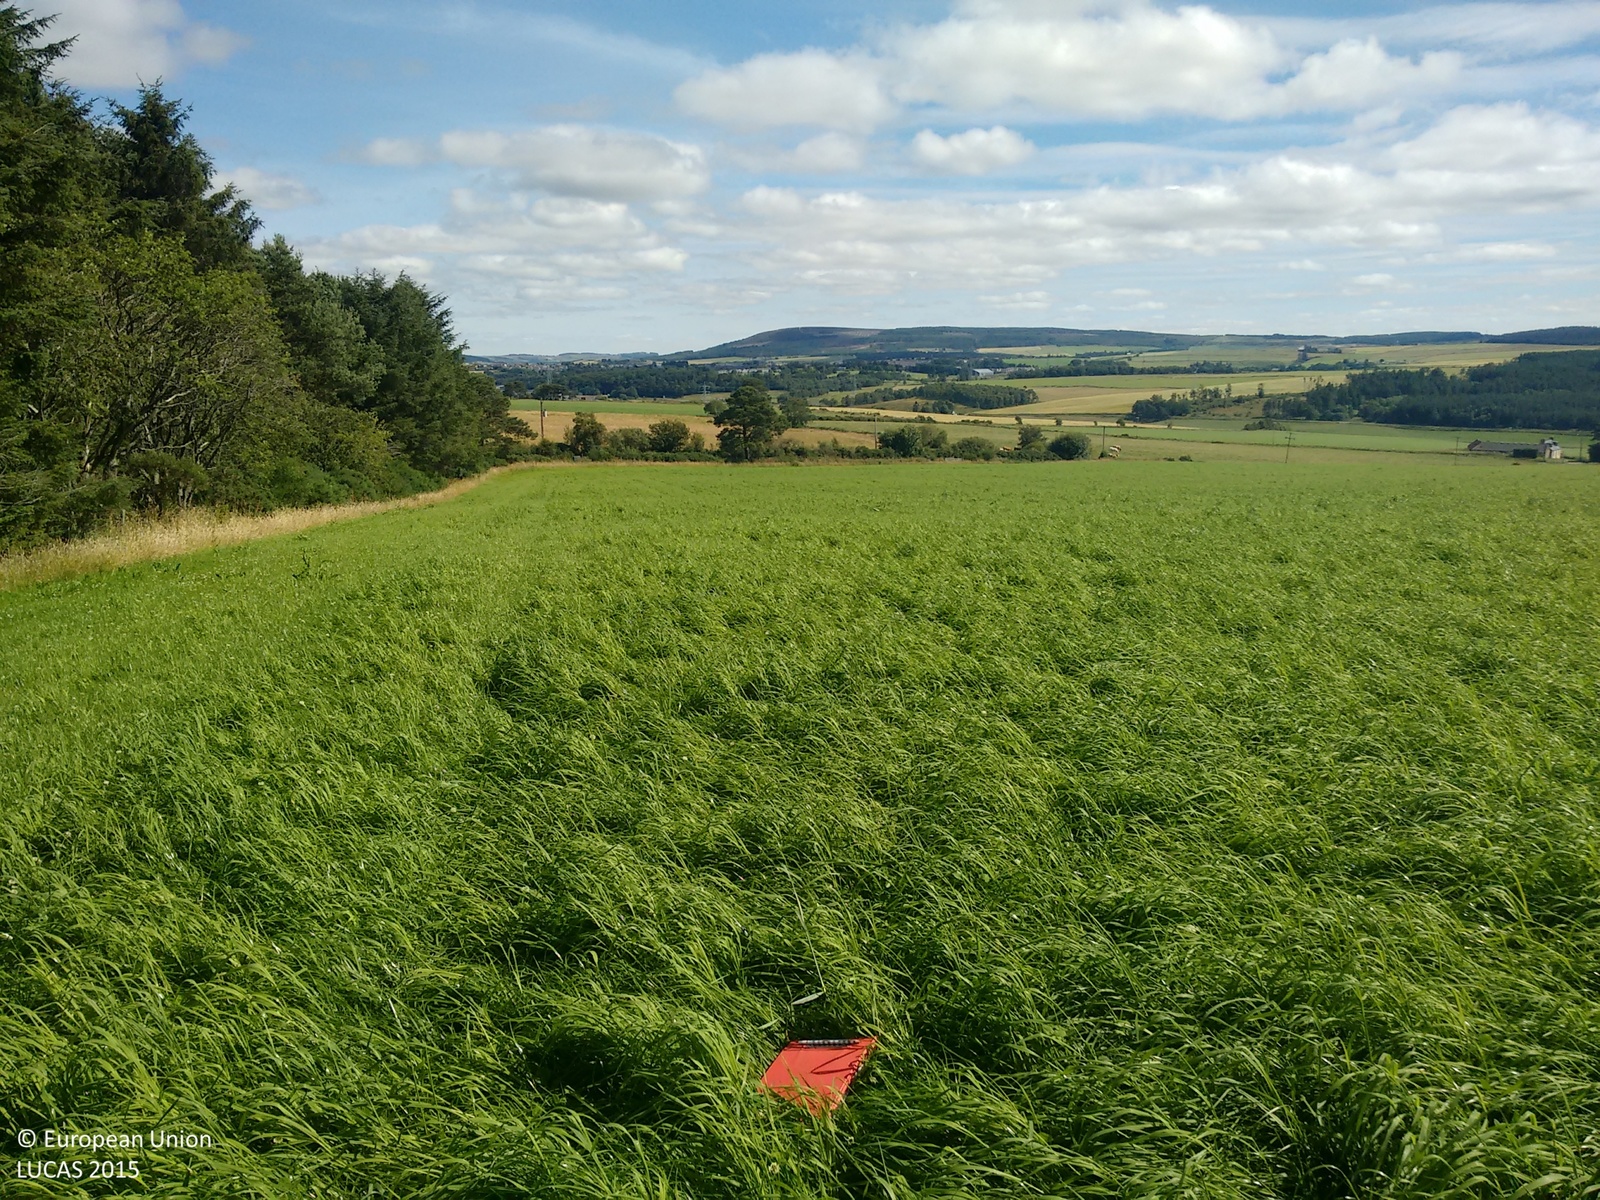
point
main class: Grassland
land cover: Grassland without tree/shrub cover
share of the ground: > 75 %
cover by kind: herbaceous plants 100 %
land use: Agriculture (excluding fallow land and kitchen gardens)
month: August
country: GB
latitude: 57.5470
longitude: -3.0104
